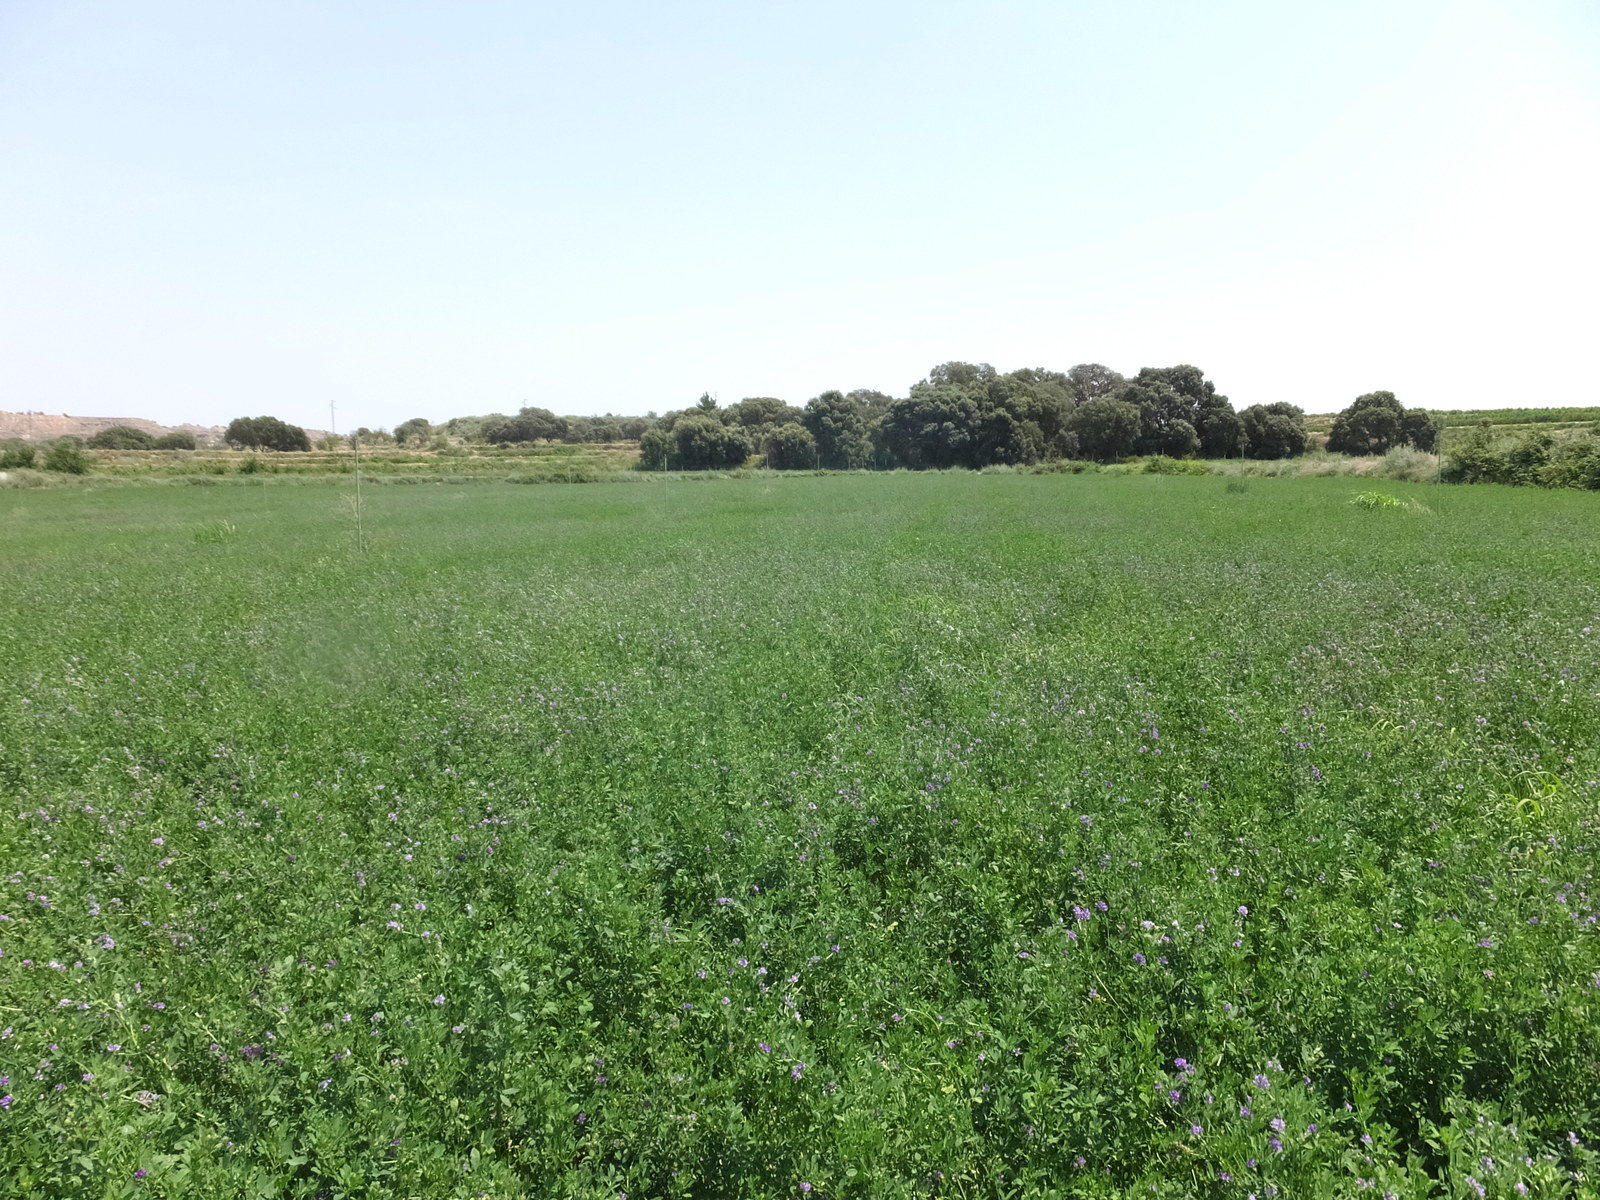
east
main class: Cropland
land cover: Lucerne
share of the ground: > 75 %
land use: Agriculture (excluding fallow land and kitchen gardens)
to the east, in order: Lucerne; Shruby margins; Lucerne; Shruby margins; Other bare soil; Shruby margins; Other bare soil; Shruby margins; Tracks; Shrubland without tree cover; Barley
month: June
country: ES
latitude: 41.8161
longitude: 0.2211
